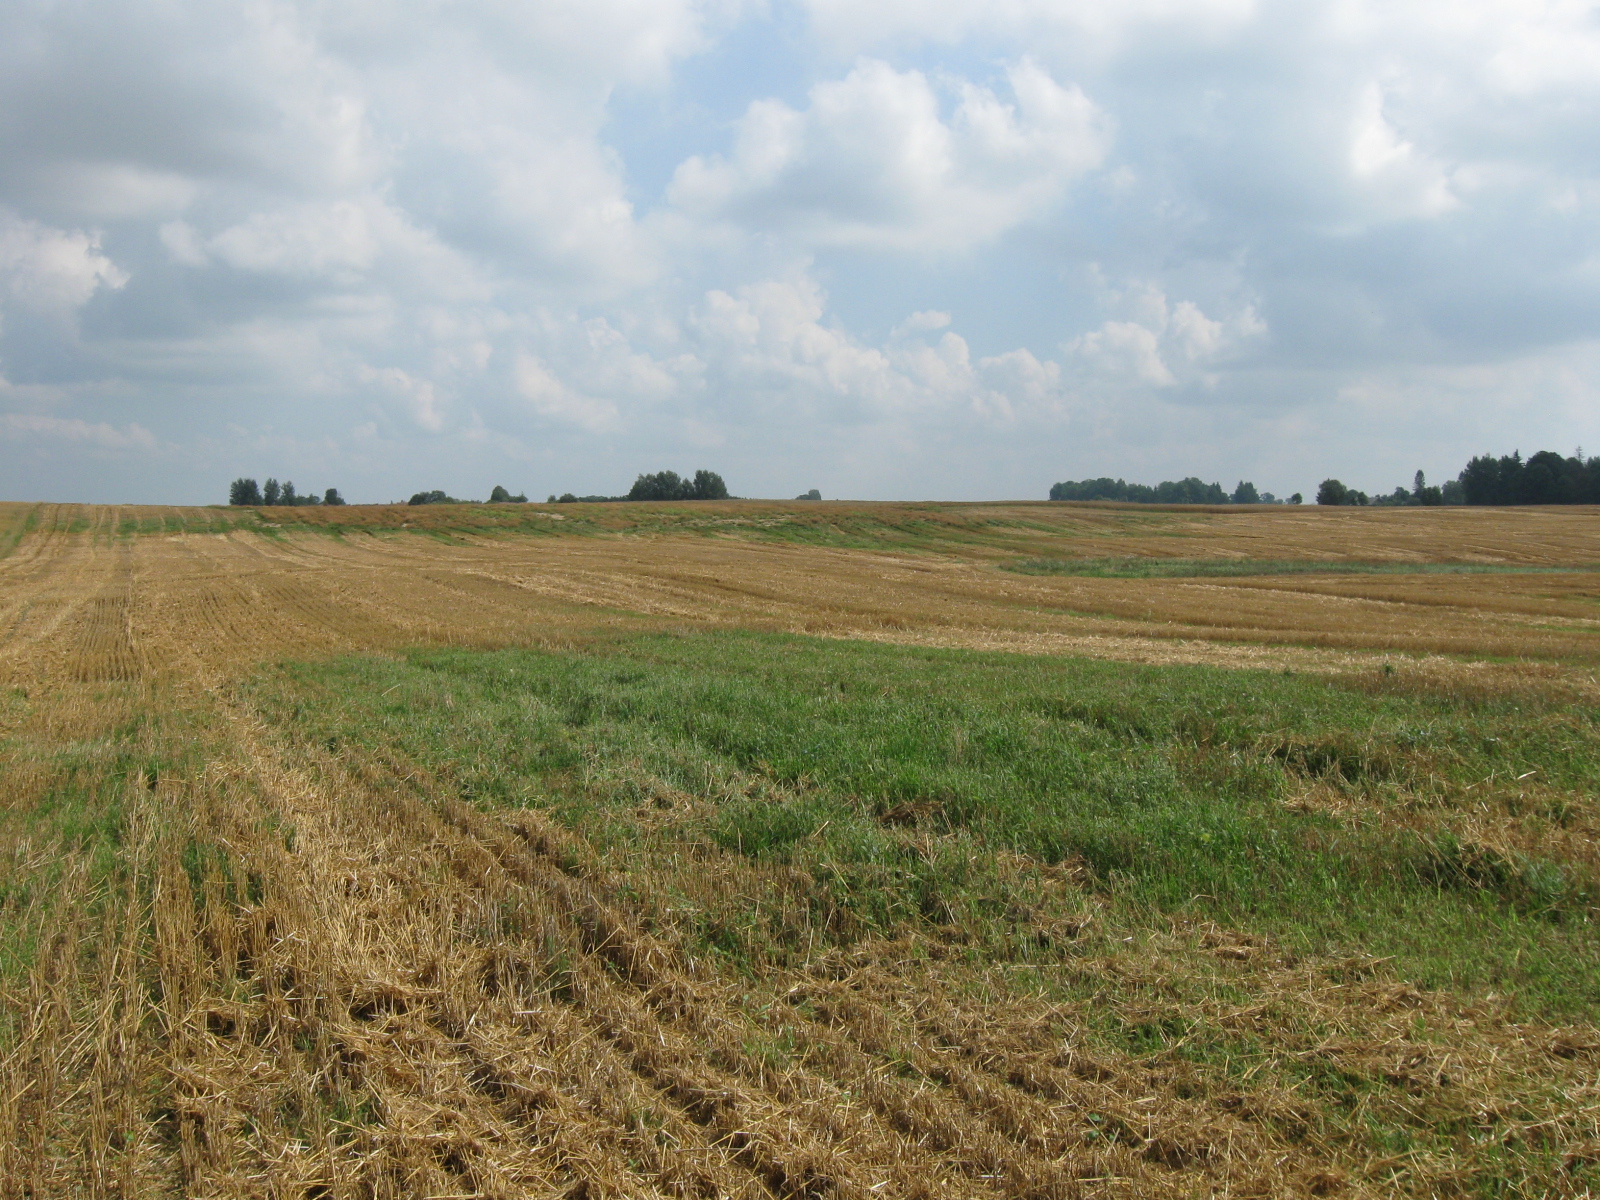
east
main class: Cropland
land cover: Common wheat
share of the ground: > 75 %
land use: Agriculture (excluding fallow land and kitchen gardens)
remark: Harvested field
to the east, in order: Common wheat; Spontaneously vegetated surfaces; Common wheat
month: August
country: LT
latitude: 54.7034
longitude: 23.6635
